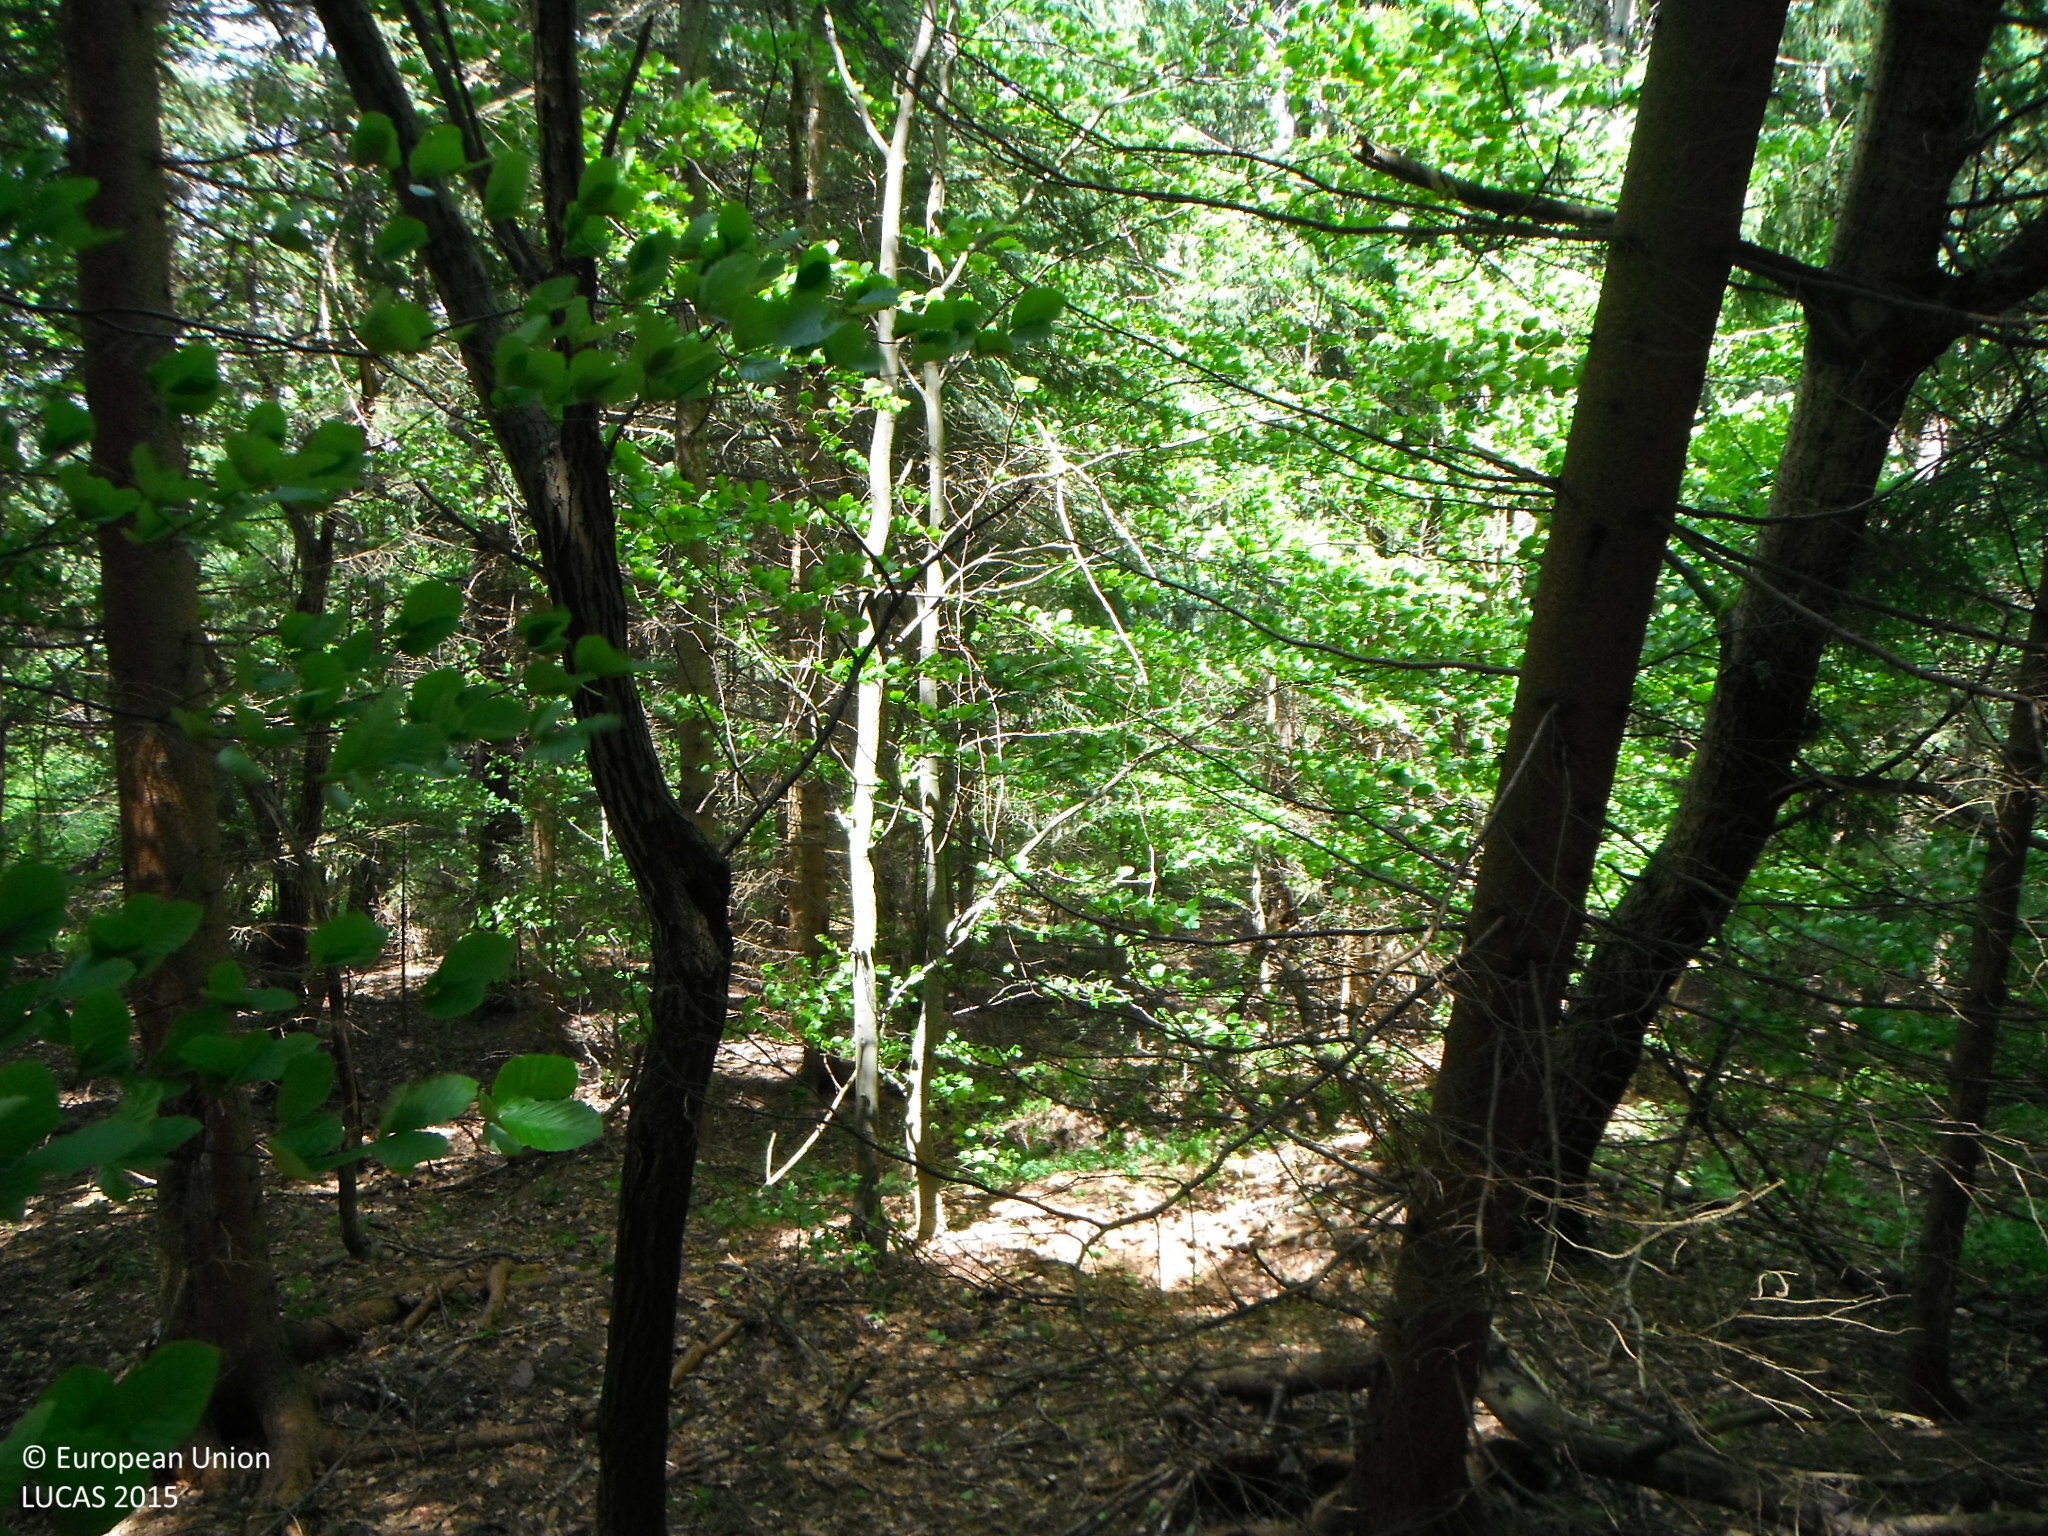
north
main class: Woodland
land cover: Spruce dominated mixed woodland
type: hemiboreal forest and nemoral coniferous forest and mixed broadleaved-coniferous forest
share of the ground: > 75 %
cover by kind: coniferous forest trees 70 %, broadleaved forest trees 30 %
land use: Forestry
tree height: > 5 m
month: May
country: SK
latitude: 48.8325
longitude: 19.2187
